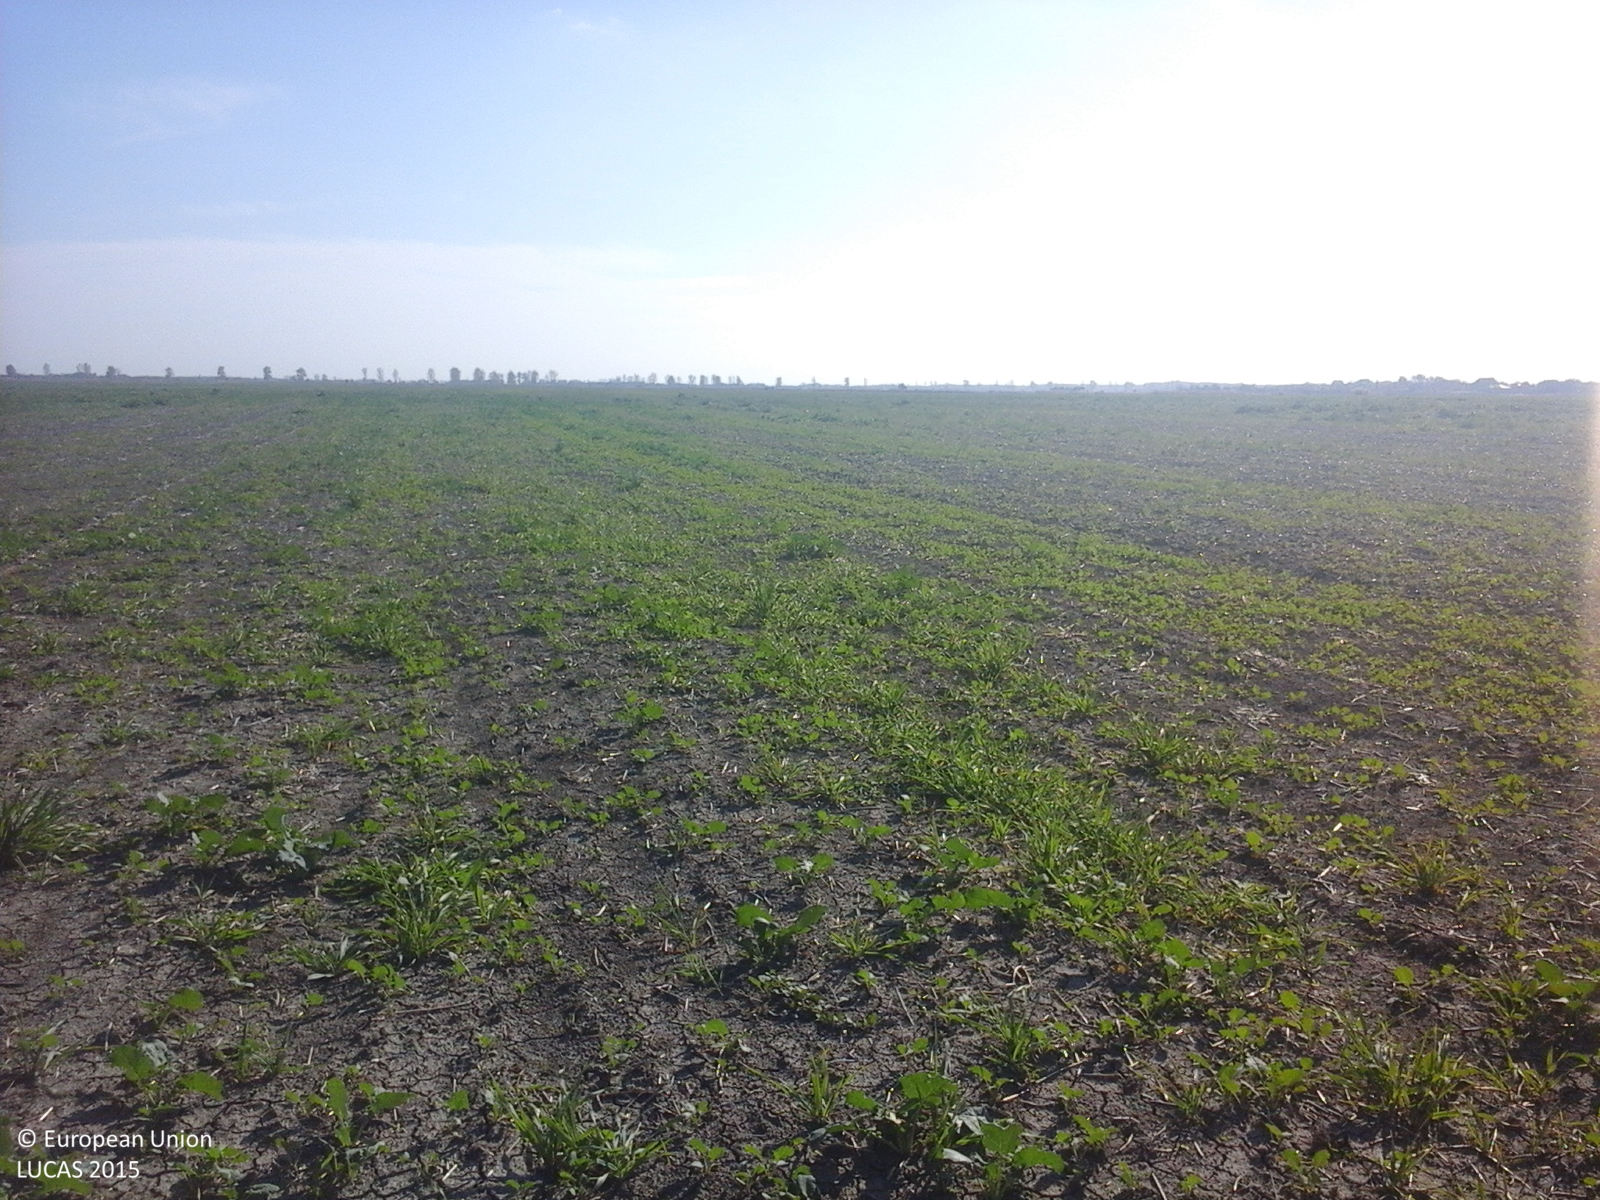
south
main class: Cropland
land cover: Common wheat
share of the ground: < 10 %
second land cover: Spontaneously vegetated surfaces
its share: 25 - 50 %
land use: Agriculture (excluding fallow land and kitchen gardens)
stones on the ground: < 10 %
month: October
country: RO
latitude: 45.3369
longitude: 27.4937
